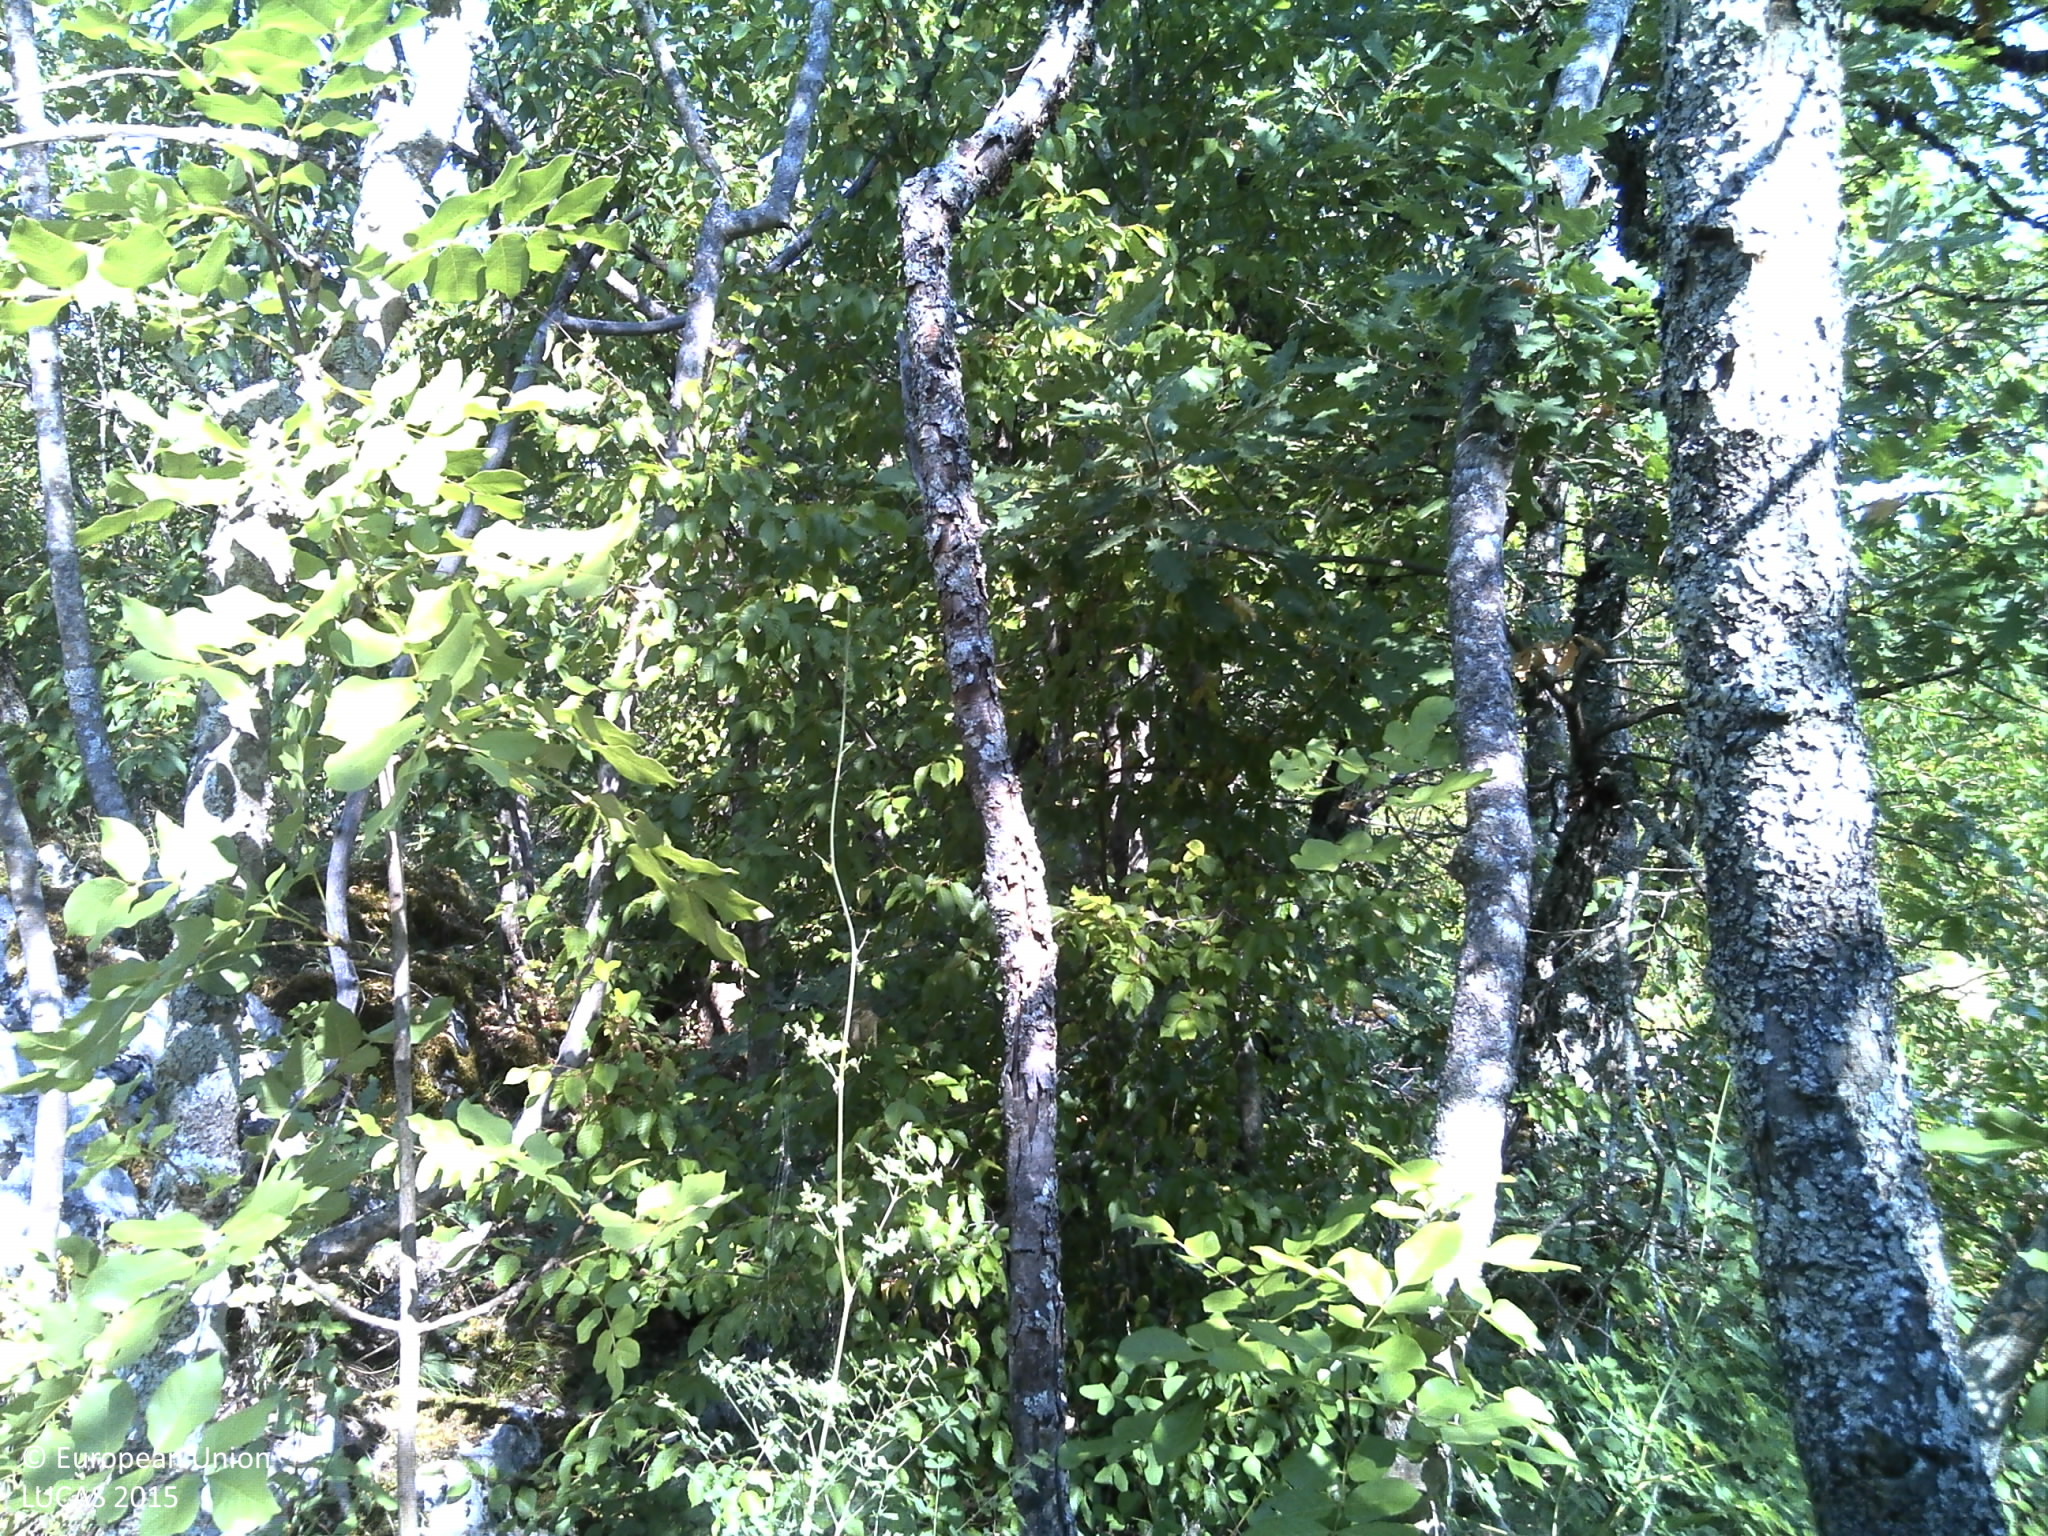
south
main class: Woodland
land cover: Broadleaved woodland
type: thermophilous deciduous forest
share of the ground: 50 - 75 %
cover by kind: broadleaved forest trees 65 %, shrubs 15 %, herbaceous plants 15 %, consolidated bare surface 5 %
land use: Semi-natural and natural areas not in use
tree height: > 5 m
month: July
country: HR
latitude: 43.4017
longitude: 17.0912
